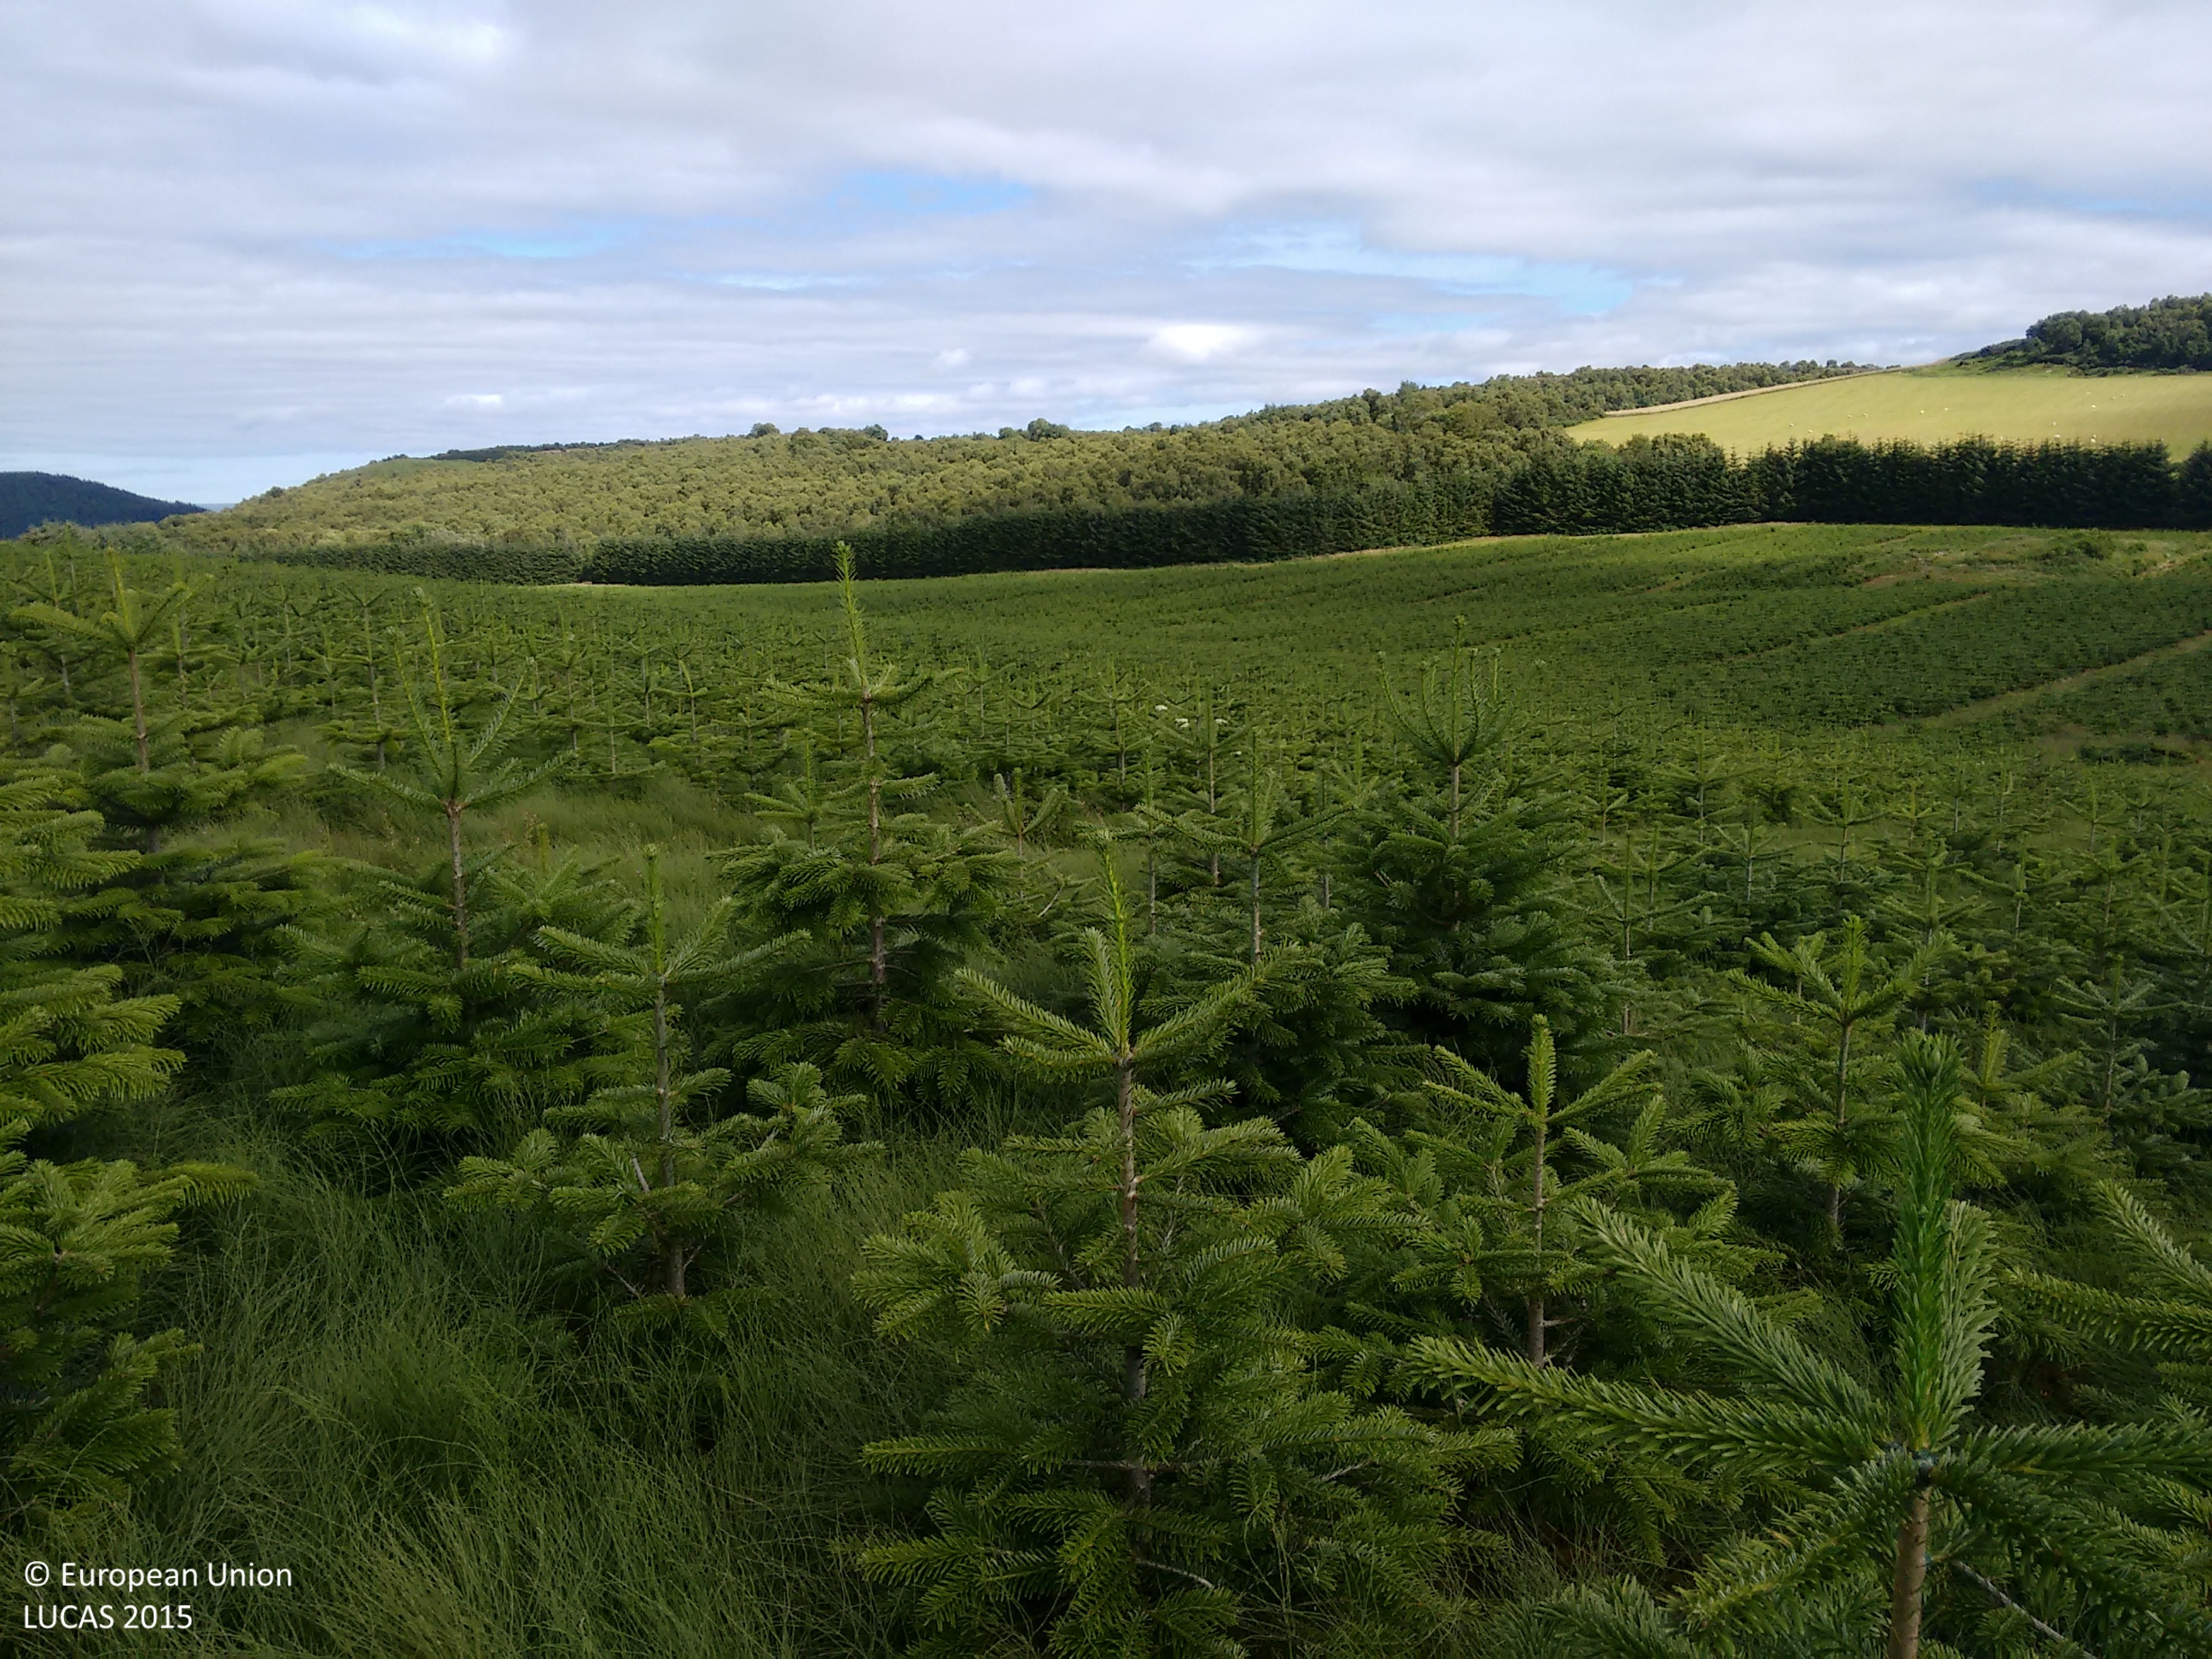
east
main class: Woodland
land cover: Spruce dominated coniferous woodland
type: exotic forest
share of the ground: > 75 %
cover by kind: coniferous forest trees 70 %, herbaceous plants 15 %, unconsolidated bare surface 15 %
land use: Forestry
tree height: < 5 m
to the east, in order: Spruce dominated coniferous woodland; Grass margins; Spruce dominated coniferous woodland; Grass margins; Spruce dominated coniferous woodland; Grass margins; Spruce dominated coniferous woodland; Grass margins; Spruce dominated coniferous woodland; Grass margins; Spruce dominated coniferous woodland
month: August
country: GB
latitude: 57.5299
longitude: -4.2306
